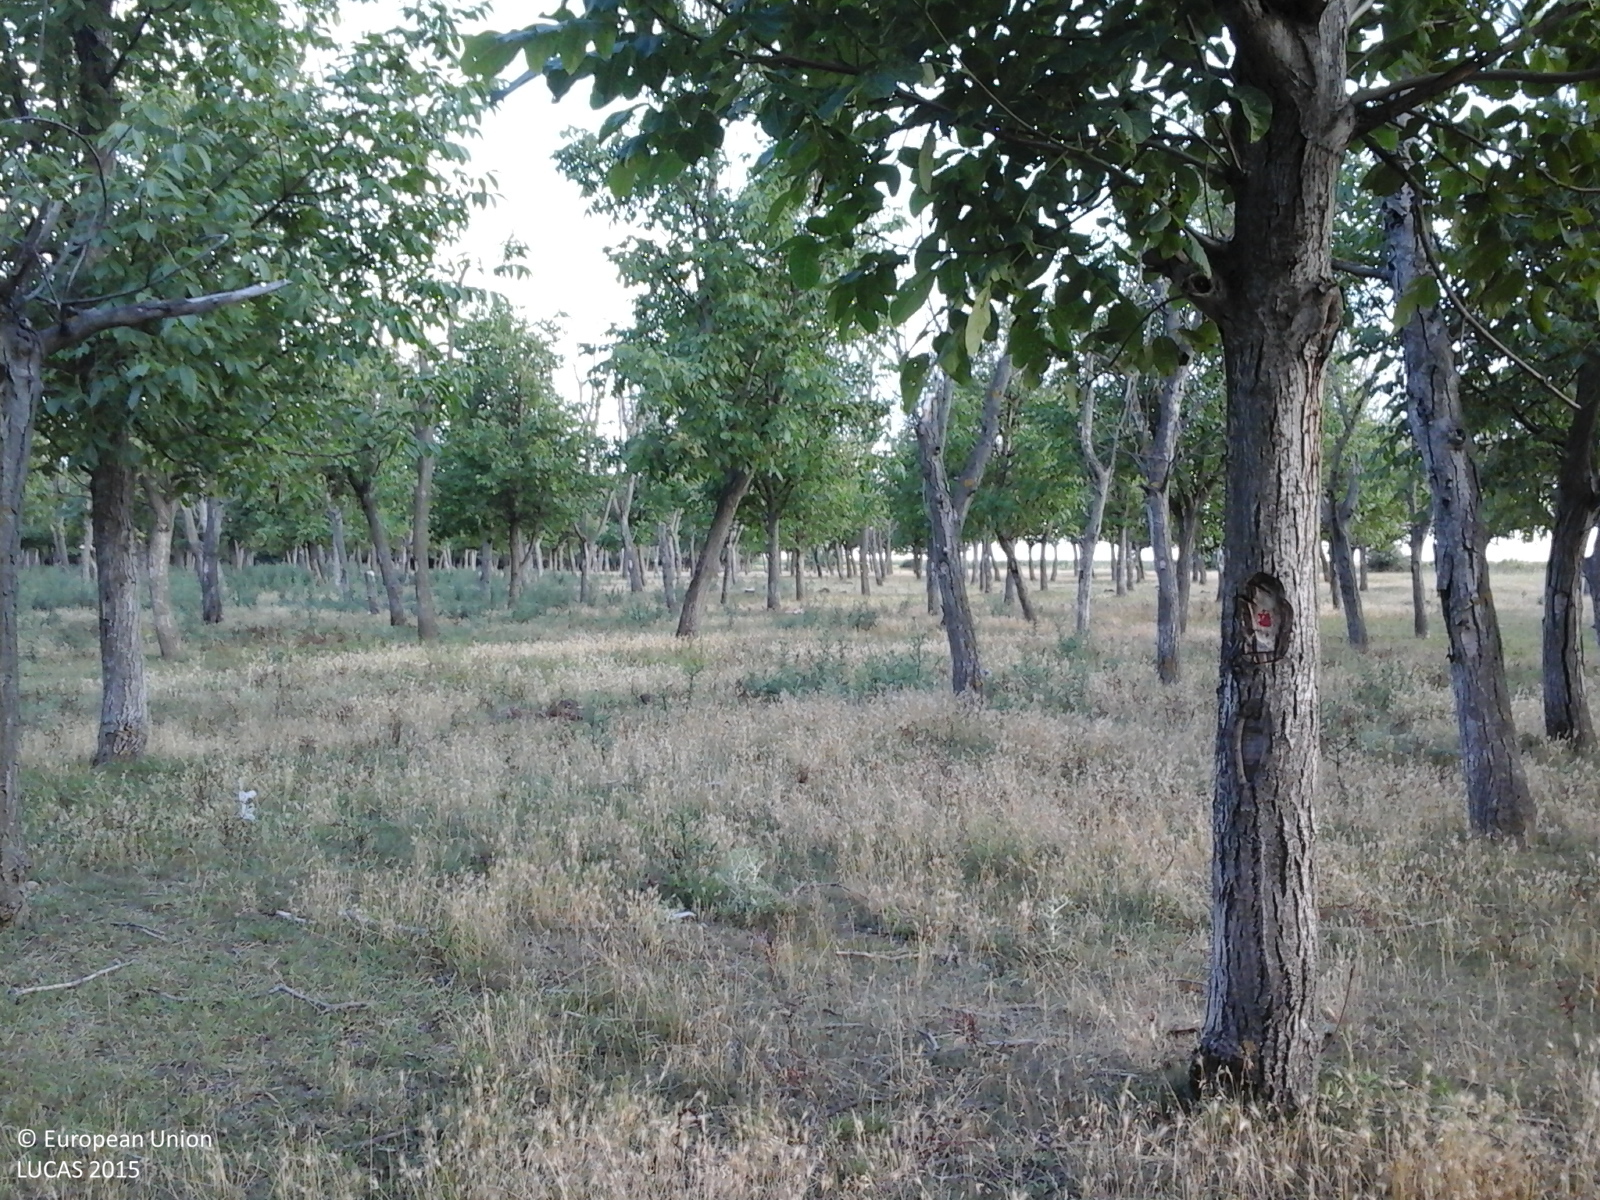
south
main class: Cropland
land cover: Nuts trees
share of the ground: 50 - 75 %
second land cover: Grassland without tree/shrub cover
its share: > 75 %
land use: Agriculture (excluding fallow land and kitchen gardens)
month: July
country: RO
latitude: 43.9432
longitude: 24.4045
